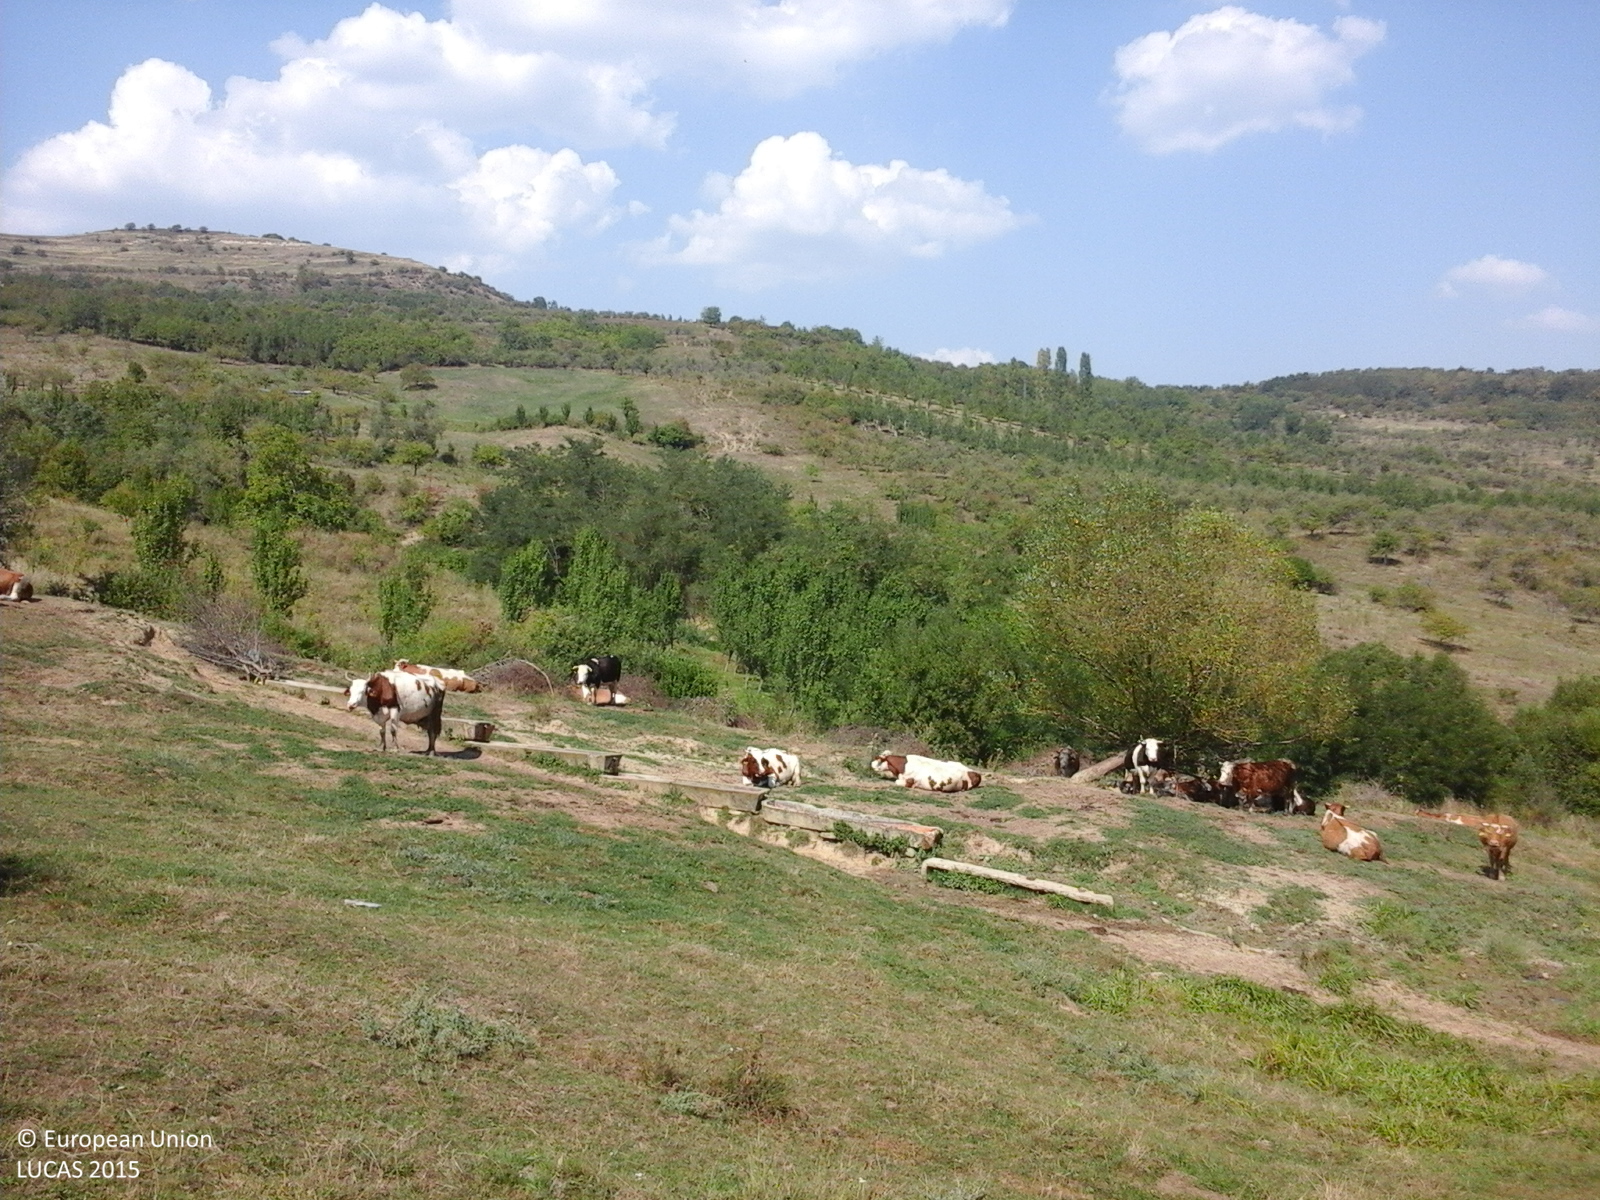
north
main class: Grassland
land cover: Grassland with sparse tree/shrub cover
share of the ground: > 75 %
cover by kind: herbaceous plants 85 %, shrubs 10 %, broadleaved forest trees 5 %
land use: Agriculture (excluding fallow land and kitchen gardens)
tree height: > 5 m
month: September
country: RO
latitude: 47.0520
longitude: 24.1289
